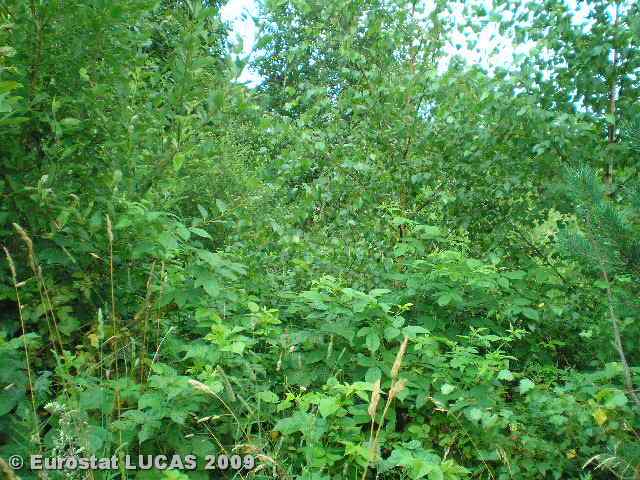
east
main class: Woodland
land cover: Broadleaved woodland
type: hemiboreal forest and nemoral coniferous forest and mixed broadleaved-coniferous forest
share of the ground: > 75 %
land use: Forestry
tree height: > 5 m
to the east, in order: Broadleaved woodland; Inland marshes; Grassland without tree/shrub cover
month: July
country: LT
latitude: 54.9839
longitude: 25.3264
